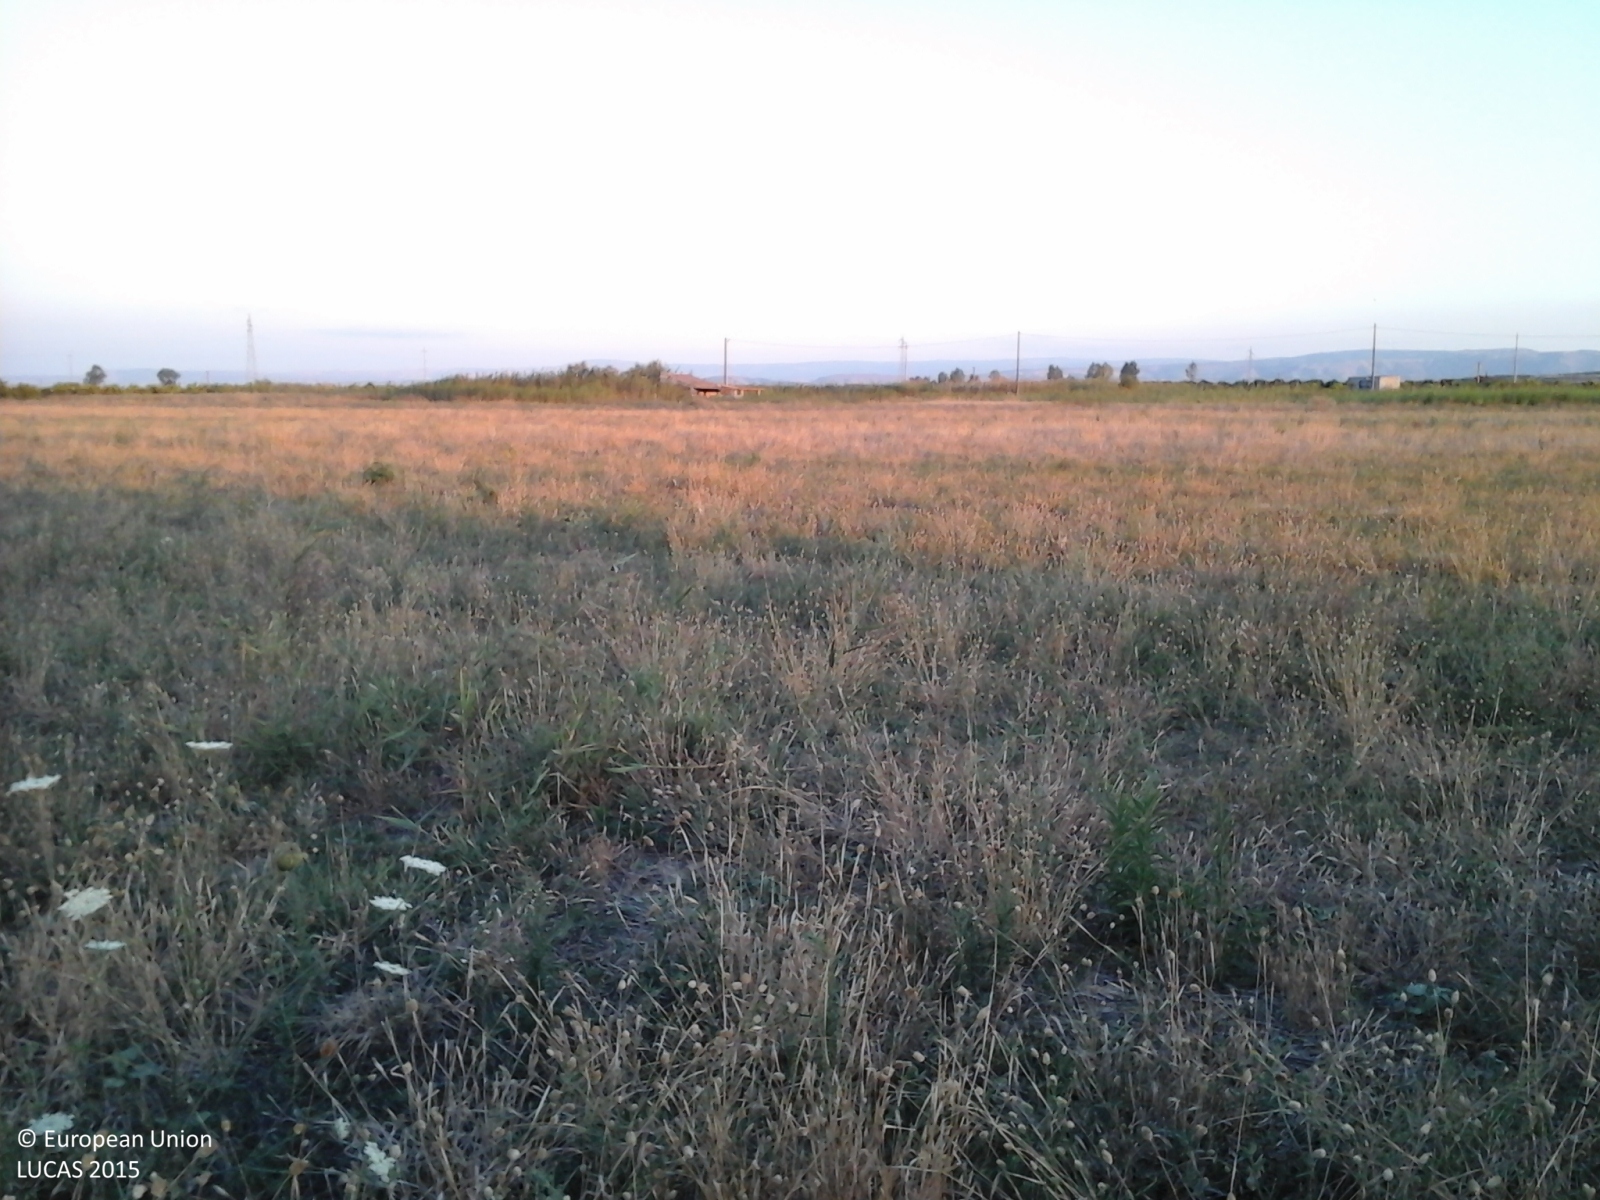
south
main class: Cropland
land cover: Mixed cereals for fodder
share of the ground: > 75 %
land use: Agriculture (excluding fallow land and kitchen gardens)
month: June
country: IT
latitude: 37.4800
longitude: 14.8163
